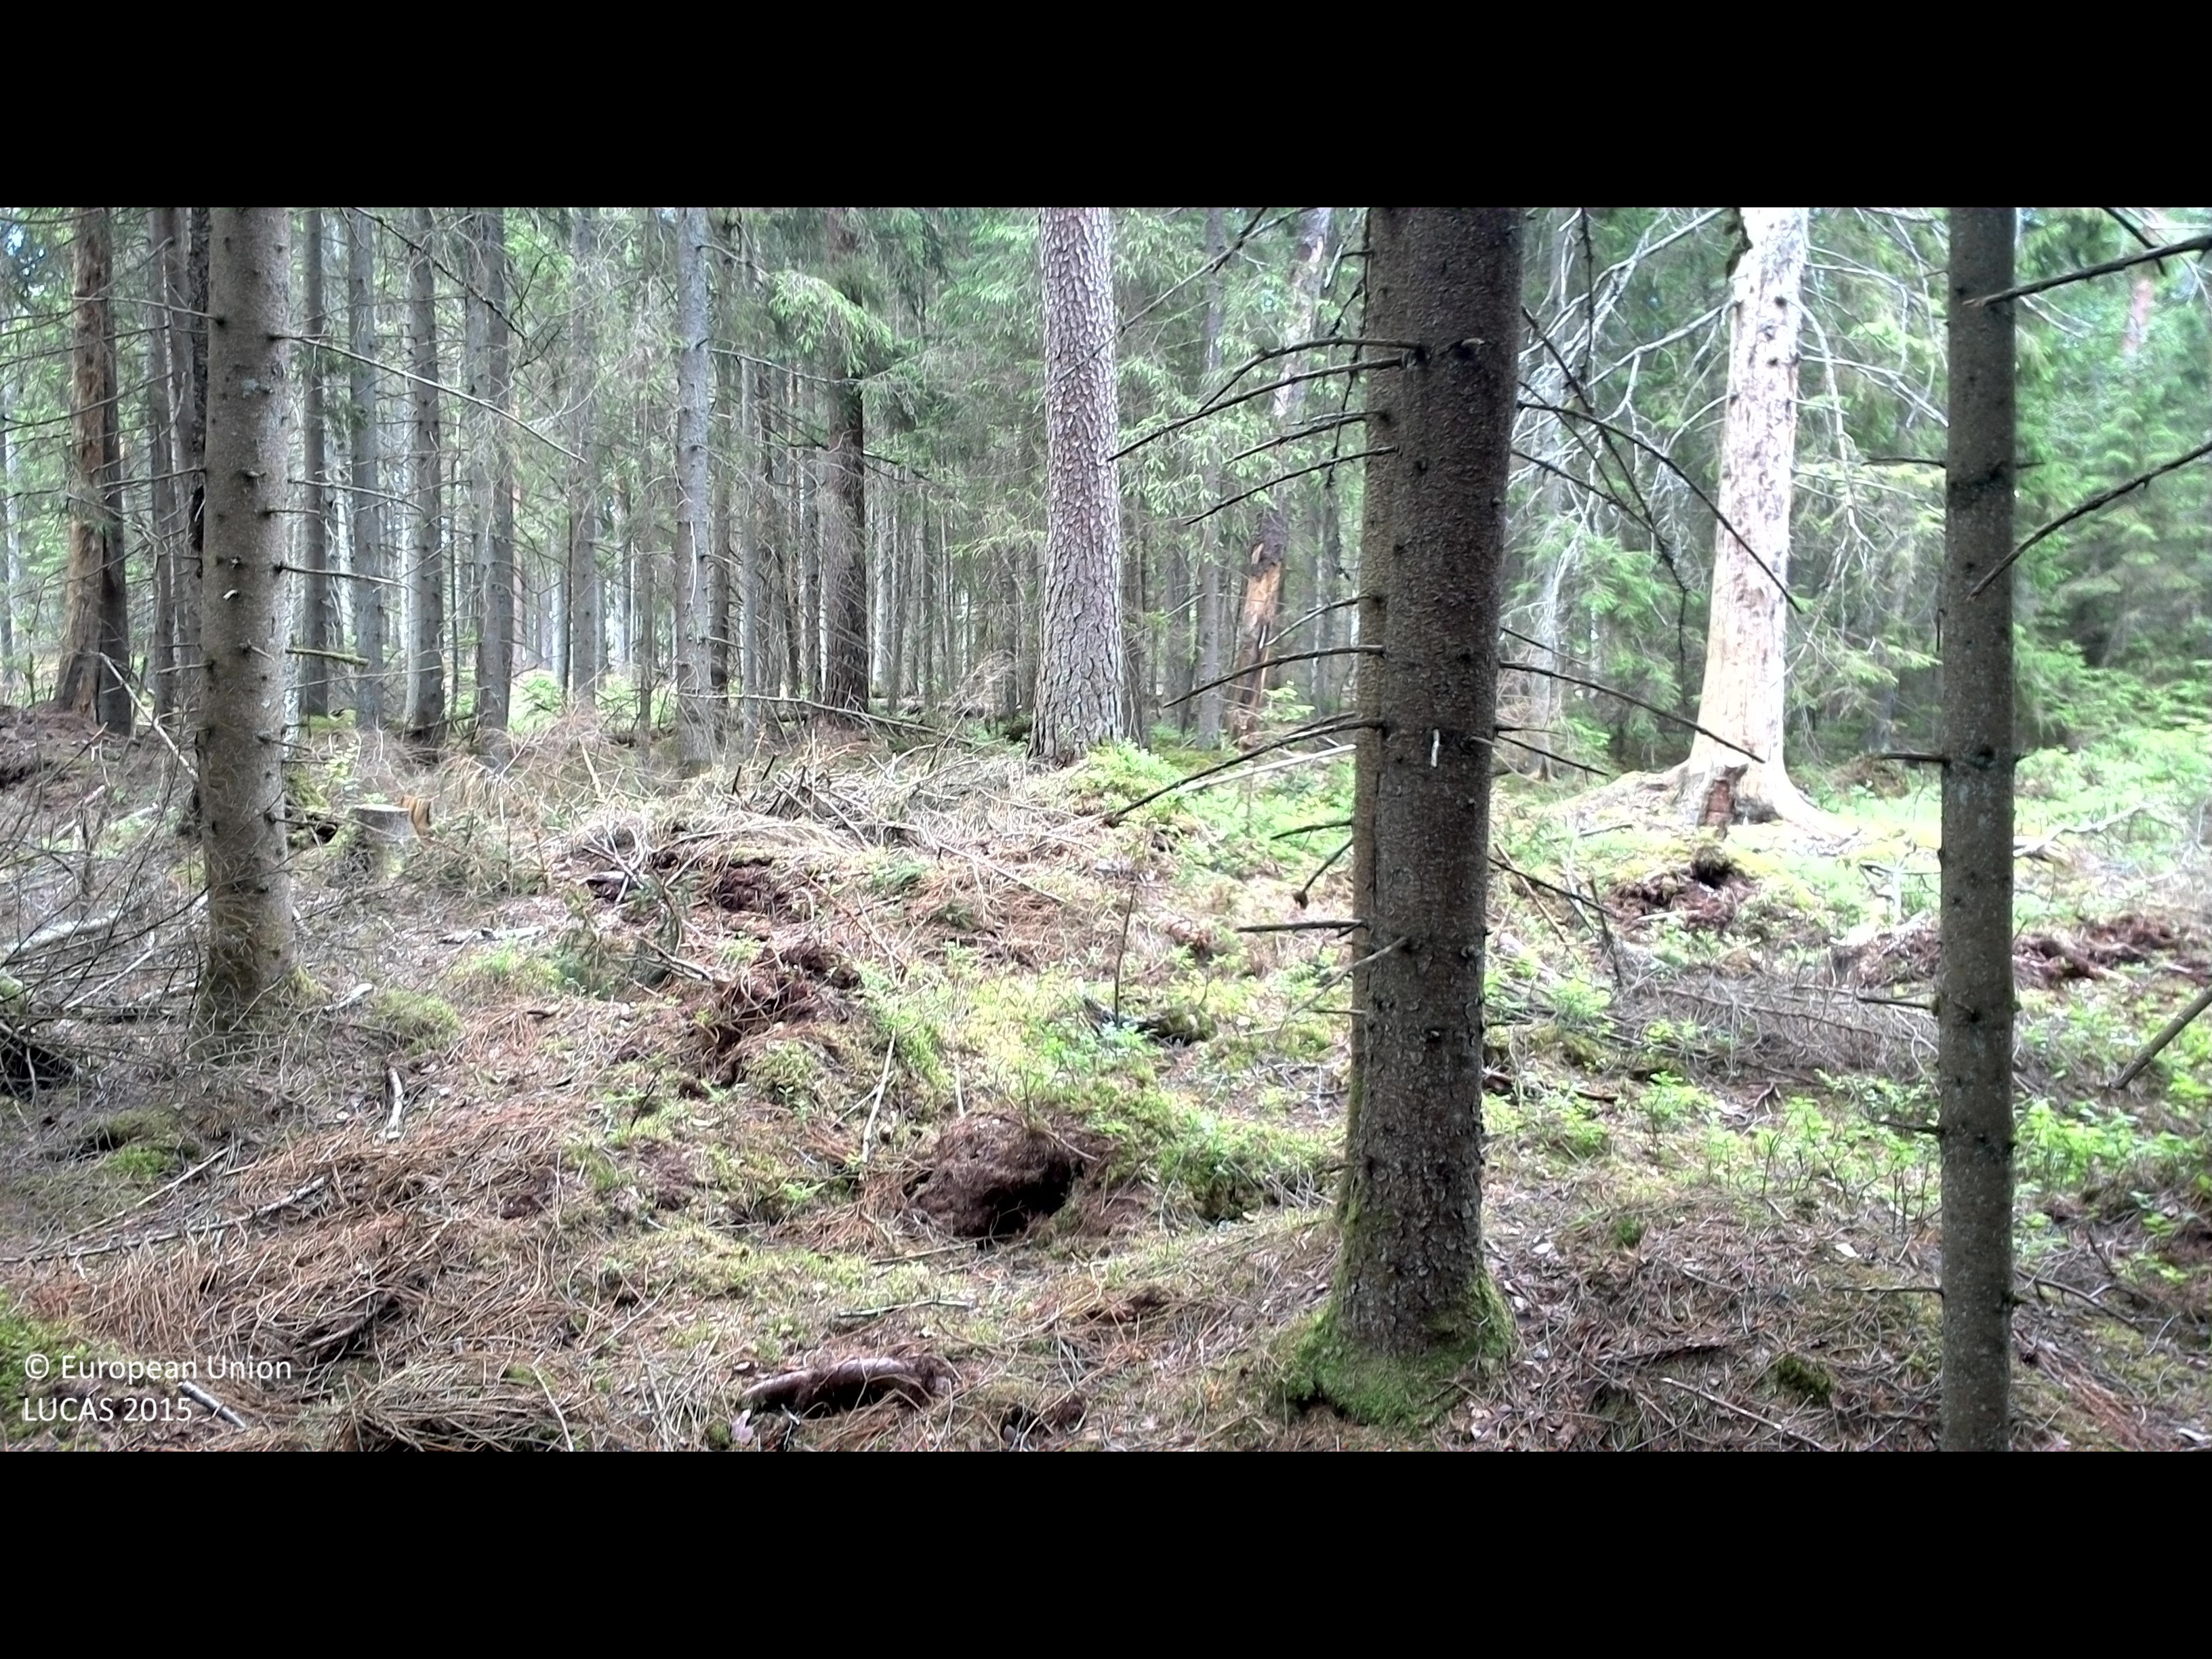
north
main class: Woodland
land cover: Spruce dominated coniferous woodland
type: boreal forest
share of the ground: 50 - 75 %
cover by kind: coniferous forest trees 75 %, lichens and mosses 15 %, shrubs 10 %
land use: Forestry
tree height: > 5 m
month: July
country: SE
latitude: 56.4093
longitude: 15.1360
